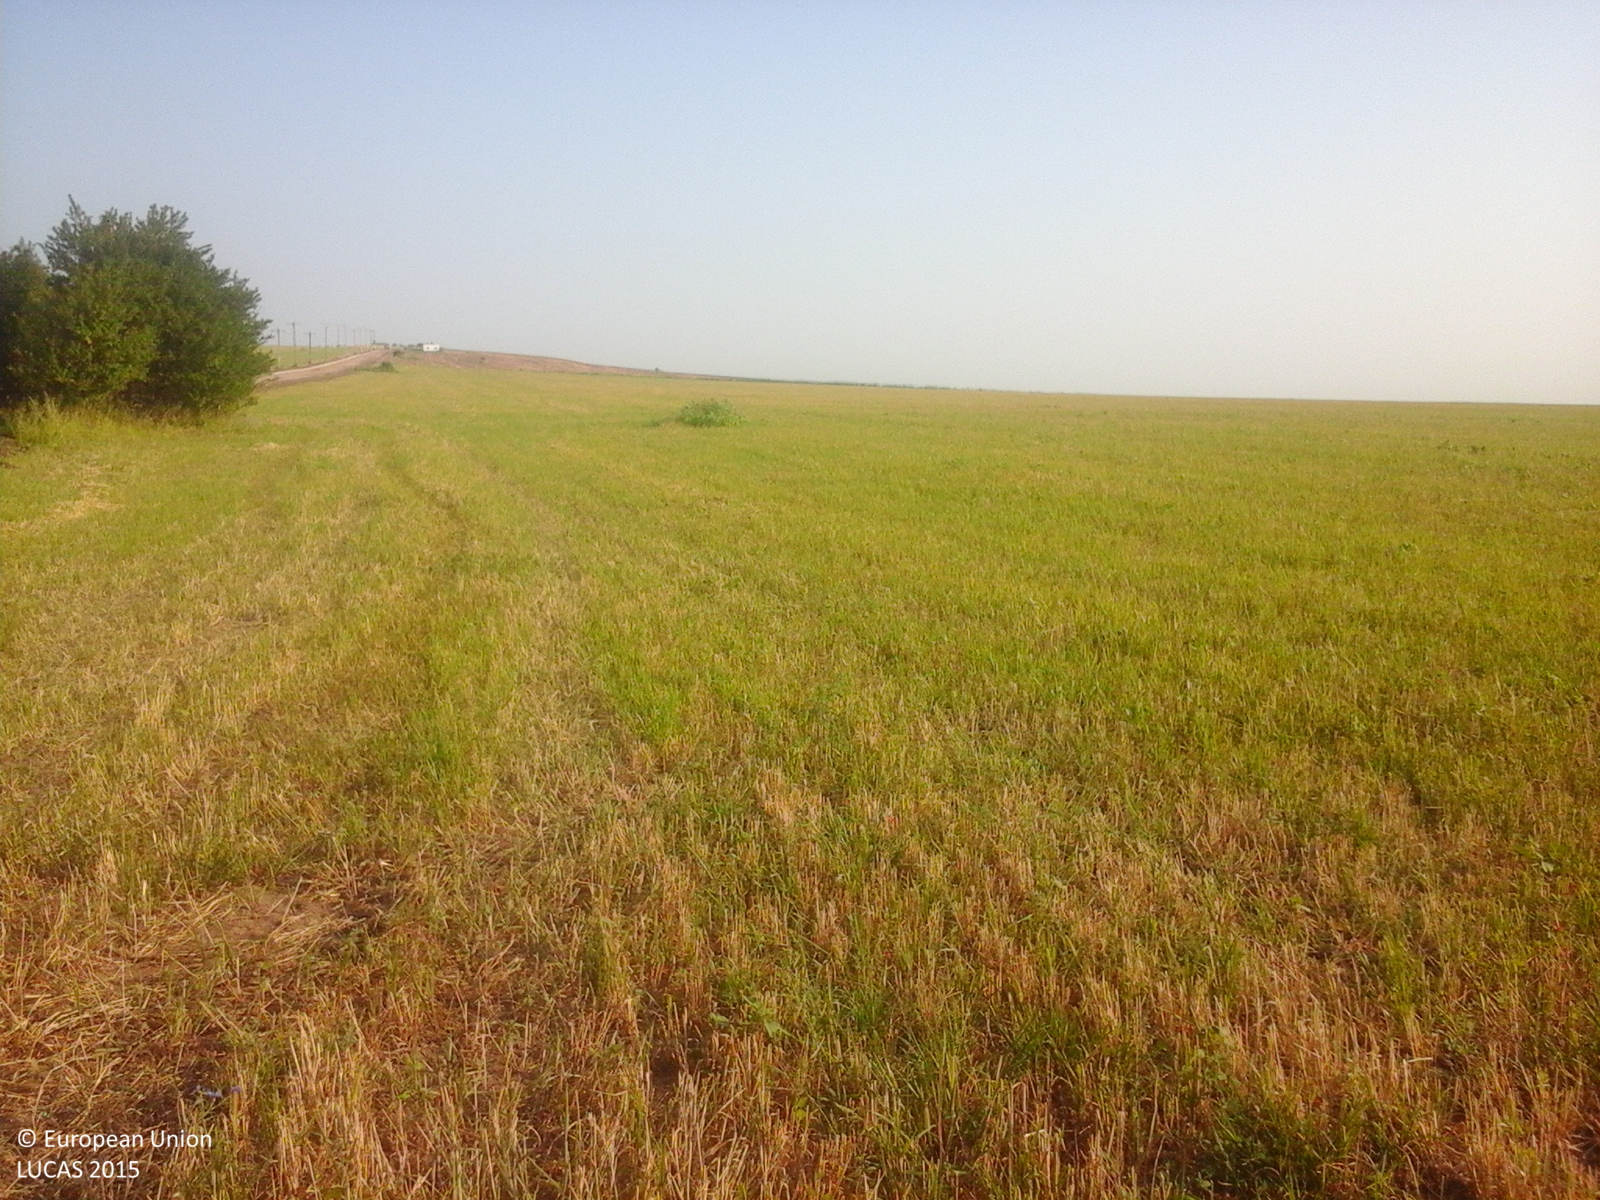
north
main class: Cropland
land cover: Durum wheat
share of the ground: > 75 %
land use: Agriculture (excluding fallow land and kitchen gardens)
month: July
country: RO
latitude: 45.9918
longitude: 28.0833
